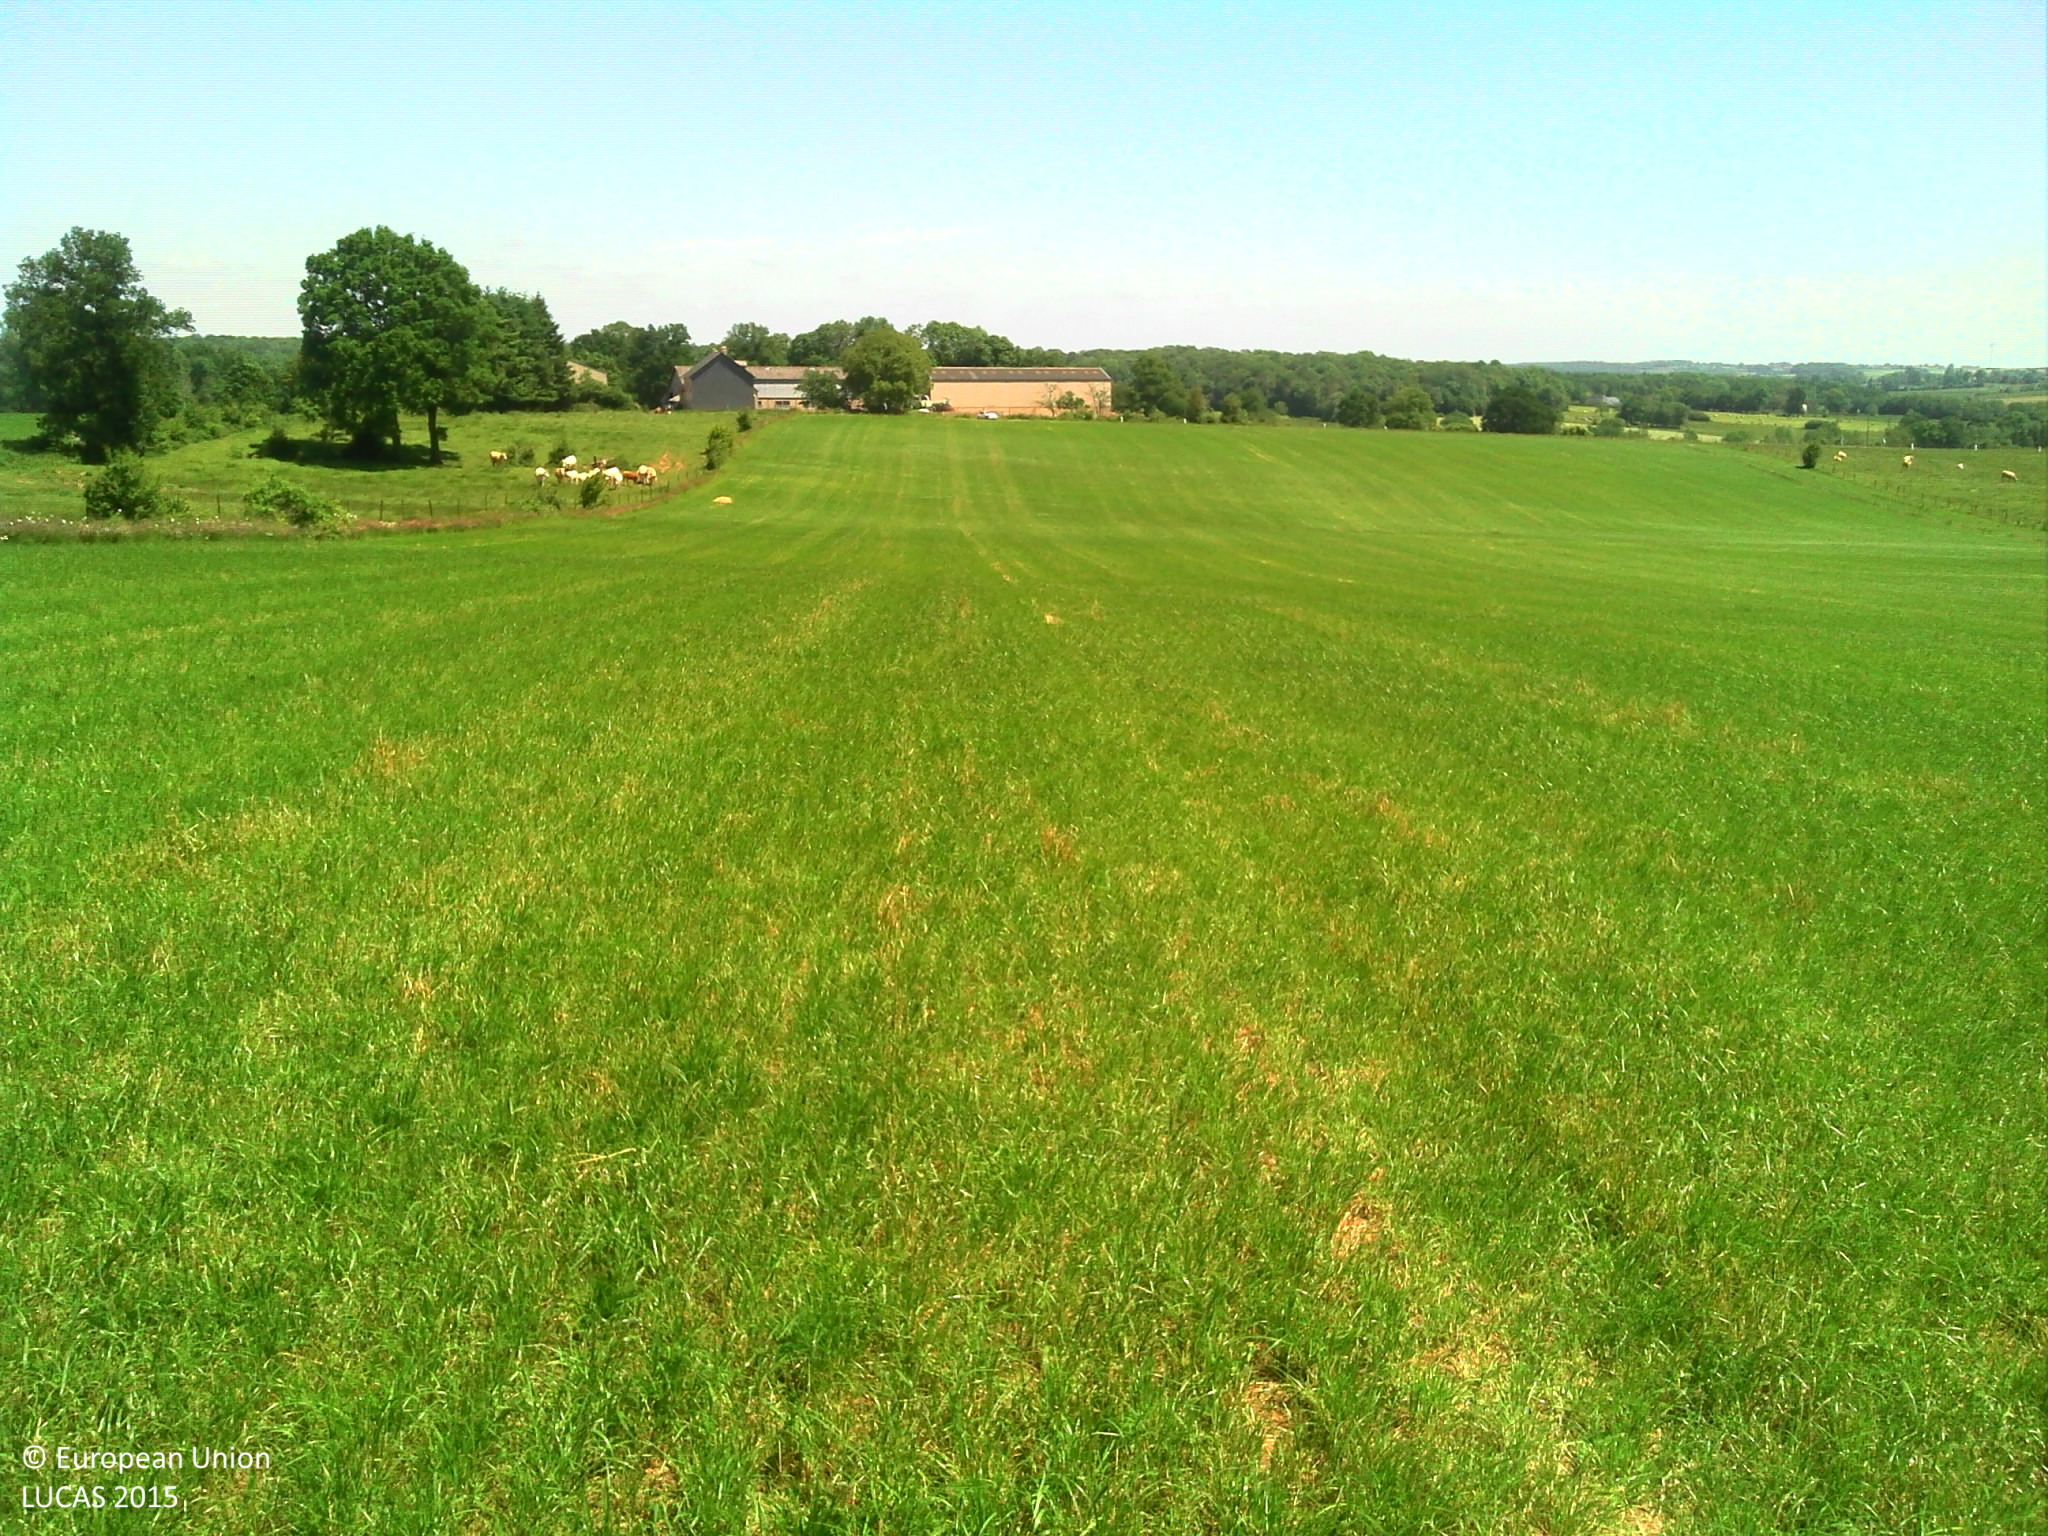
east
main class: Cropland
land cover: Temporary grasslands
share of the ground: > 75 %
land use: Agriculture (excluding fallow land and kitchen gardens)
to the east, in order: Temporary grasslands
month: June
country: FR
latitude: 49.8933
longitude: 4.2183
